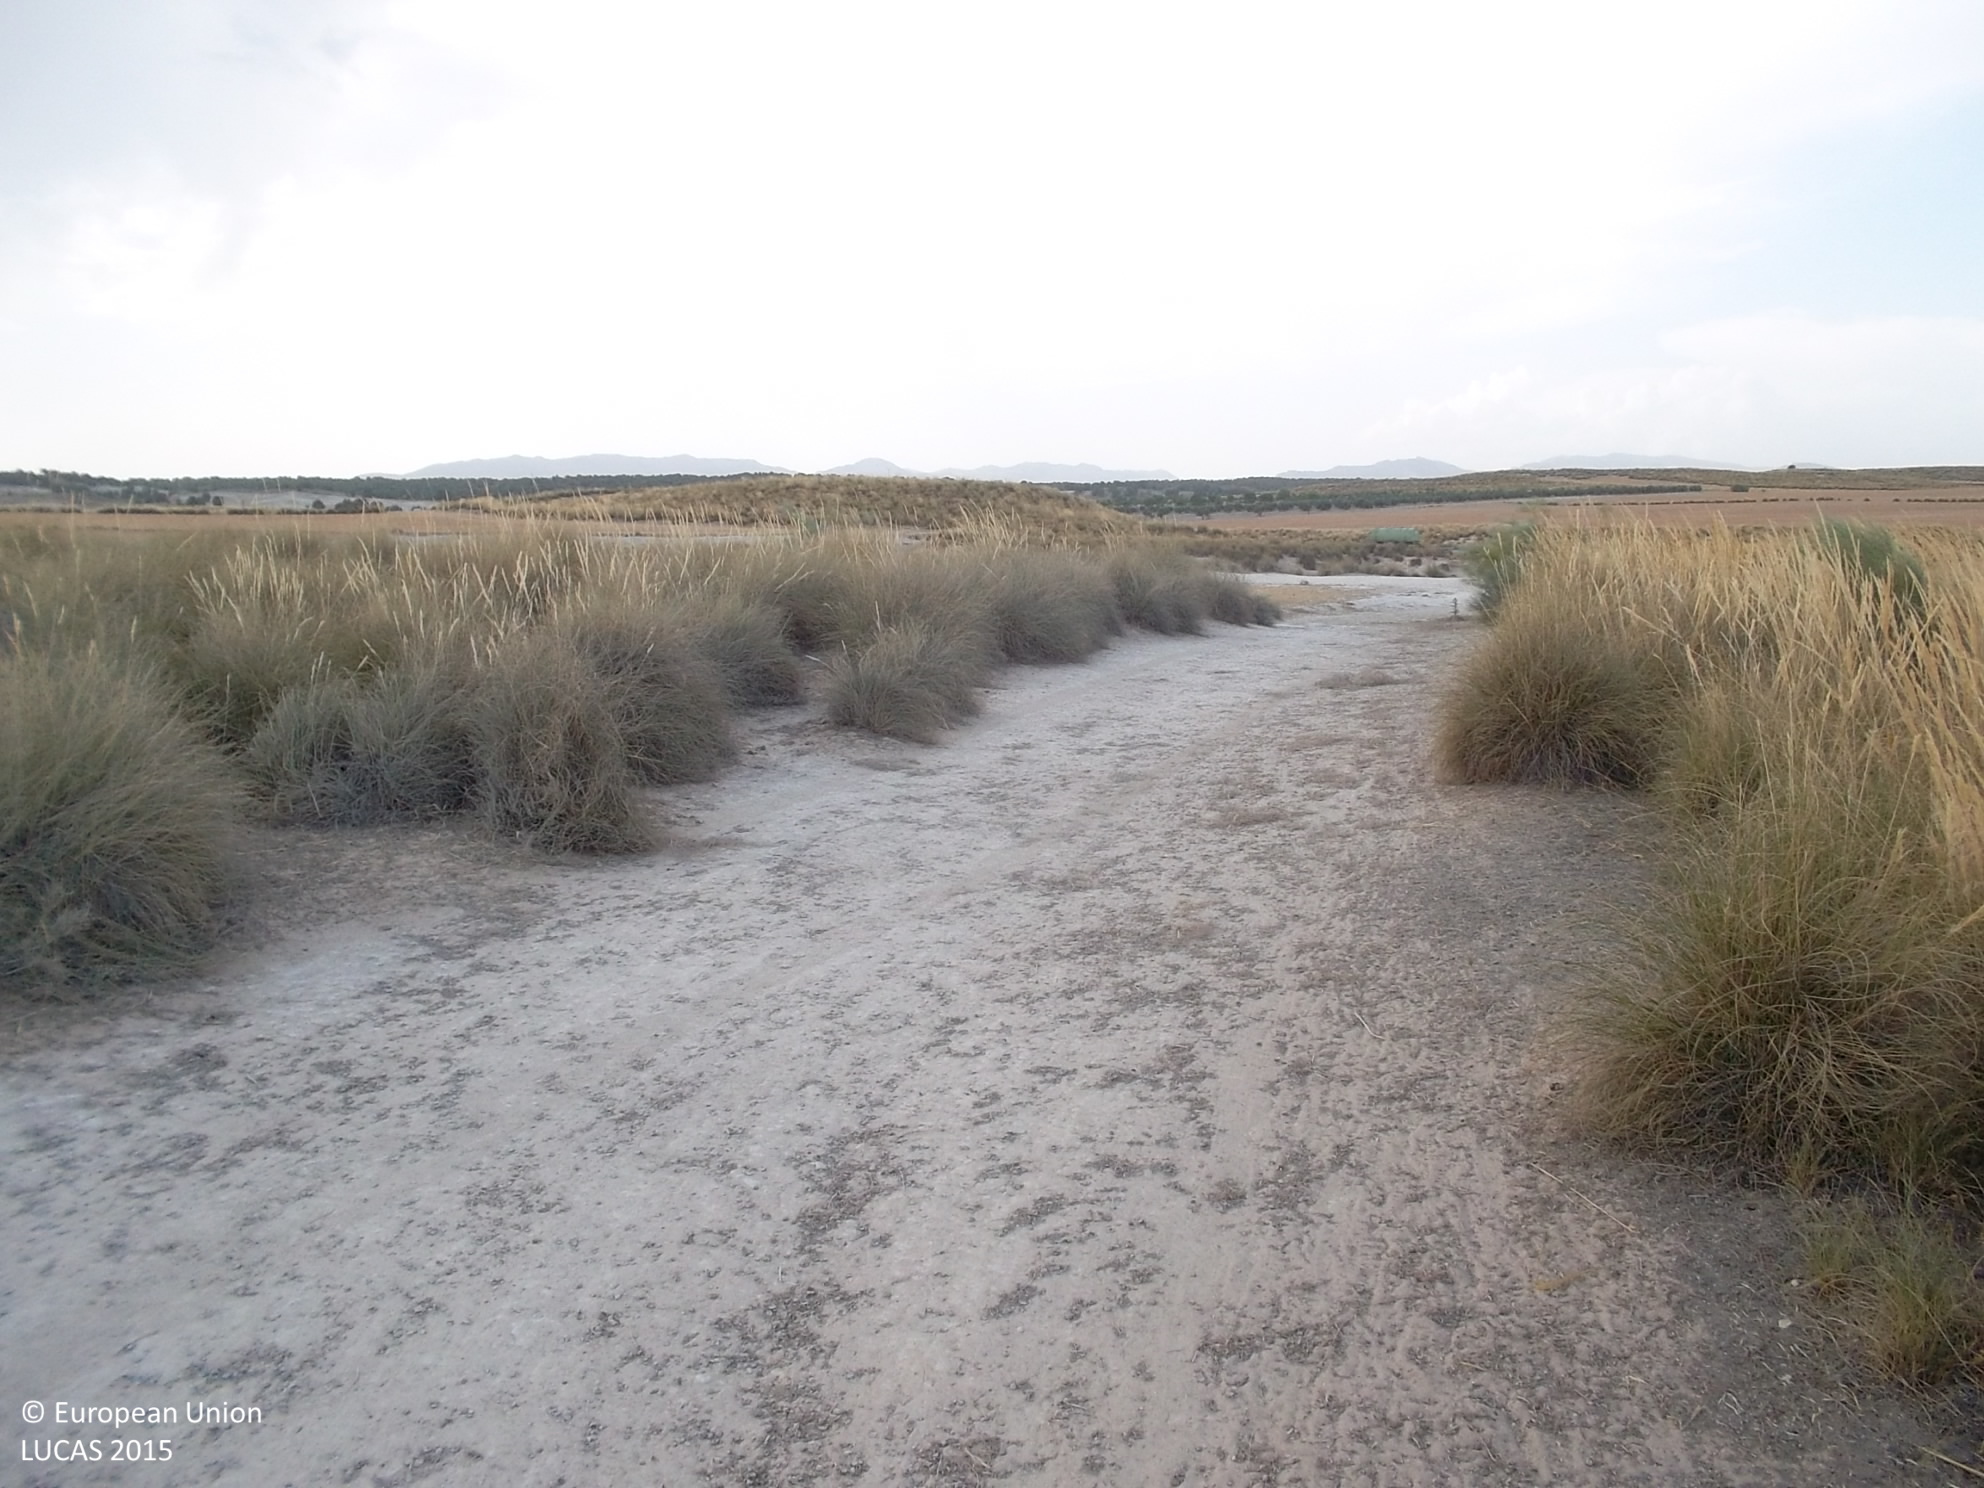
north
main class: Grassland
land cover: Grassland without tree/shrub cover
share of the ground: 50 - 75 %
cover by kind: herbaceous plants 65 %, unconsolidated bare surface 35 %
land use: Agriculture (excluding fallow land and kitchen gardens)
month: July
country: ES
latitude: 37.6776
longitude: -2.7225
